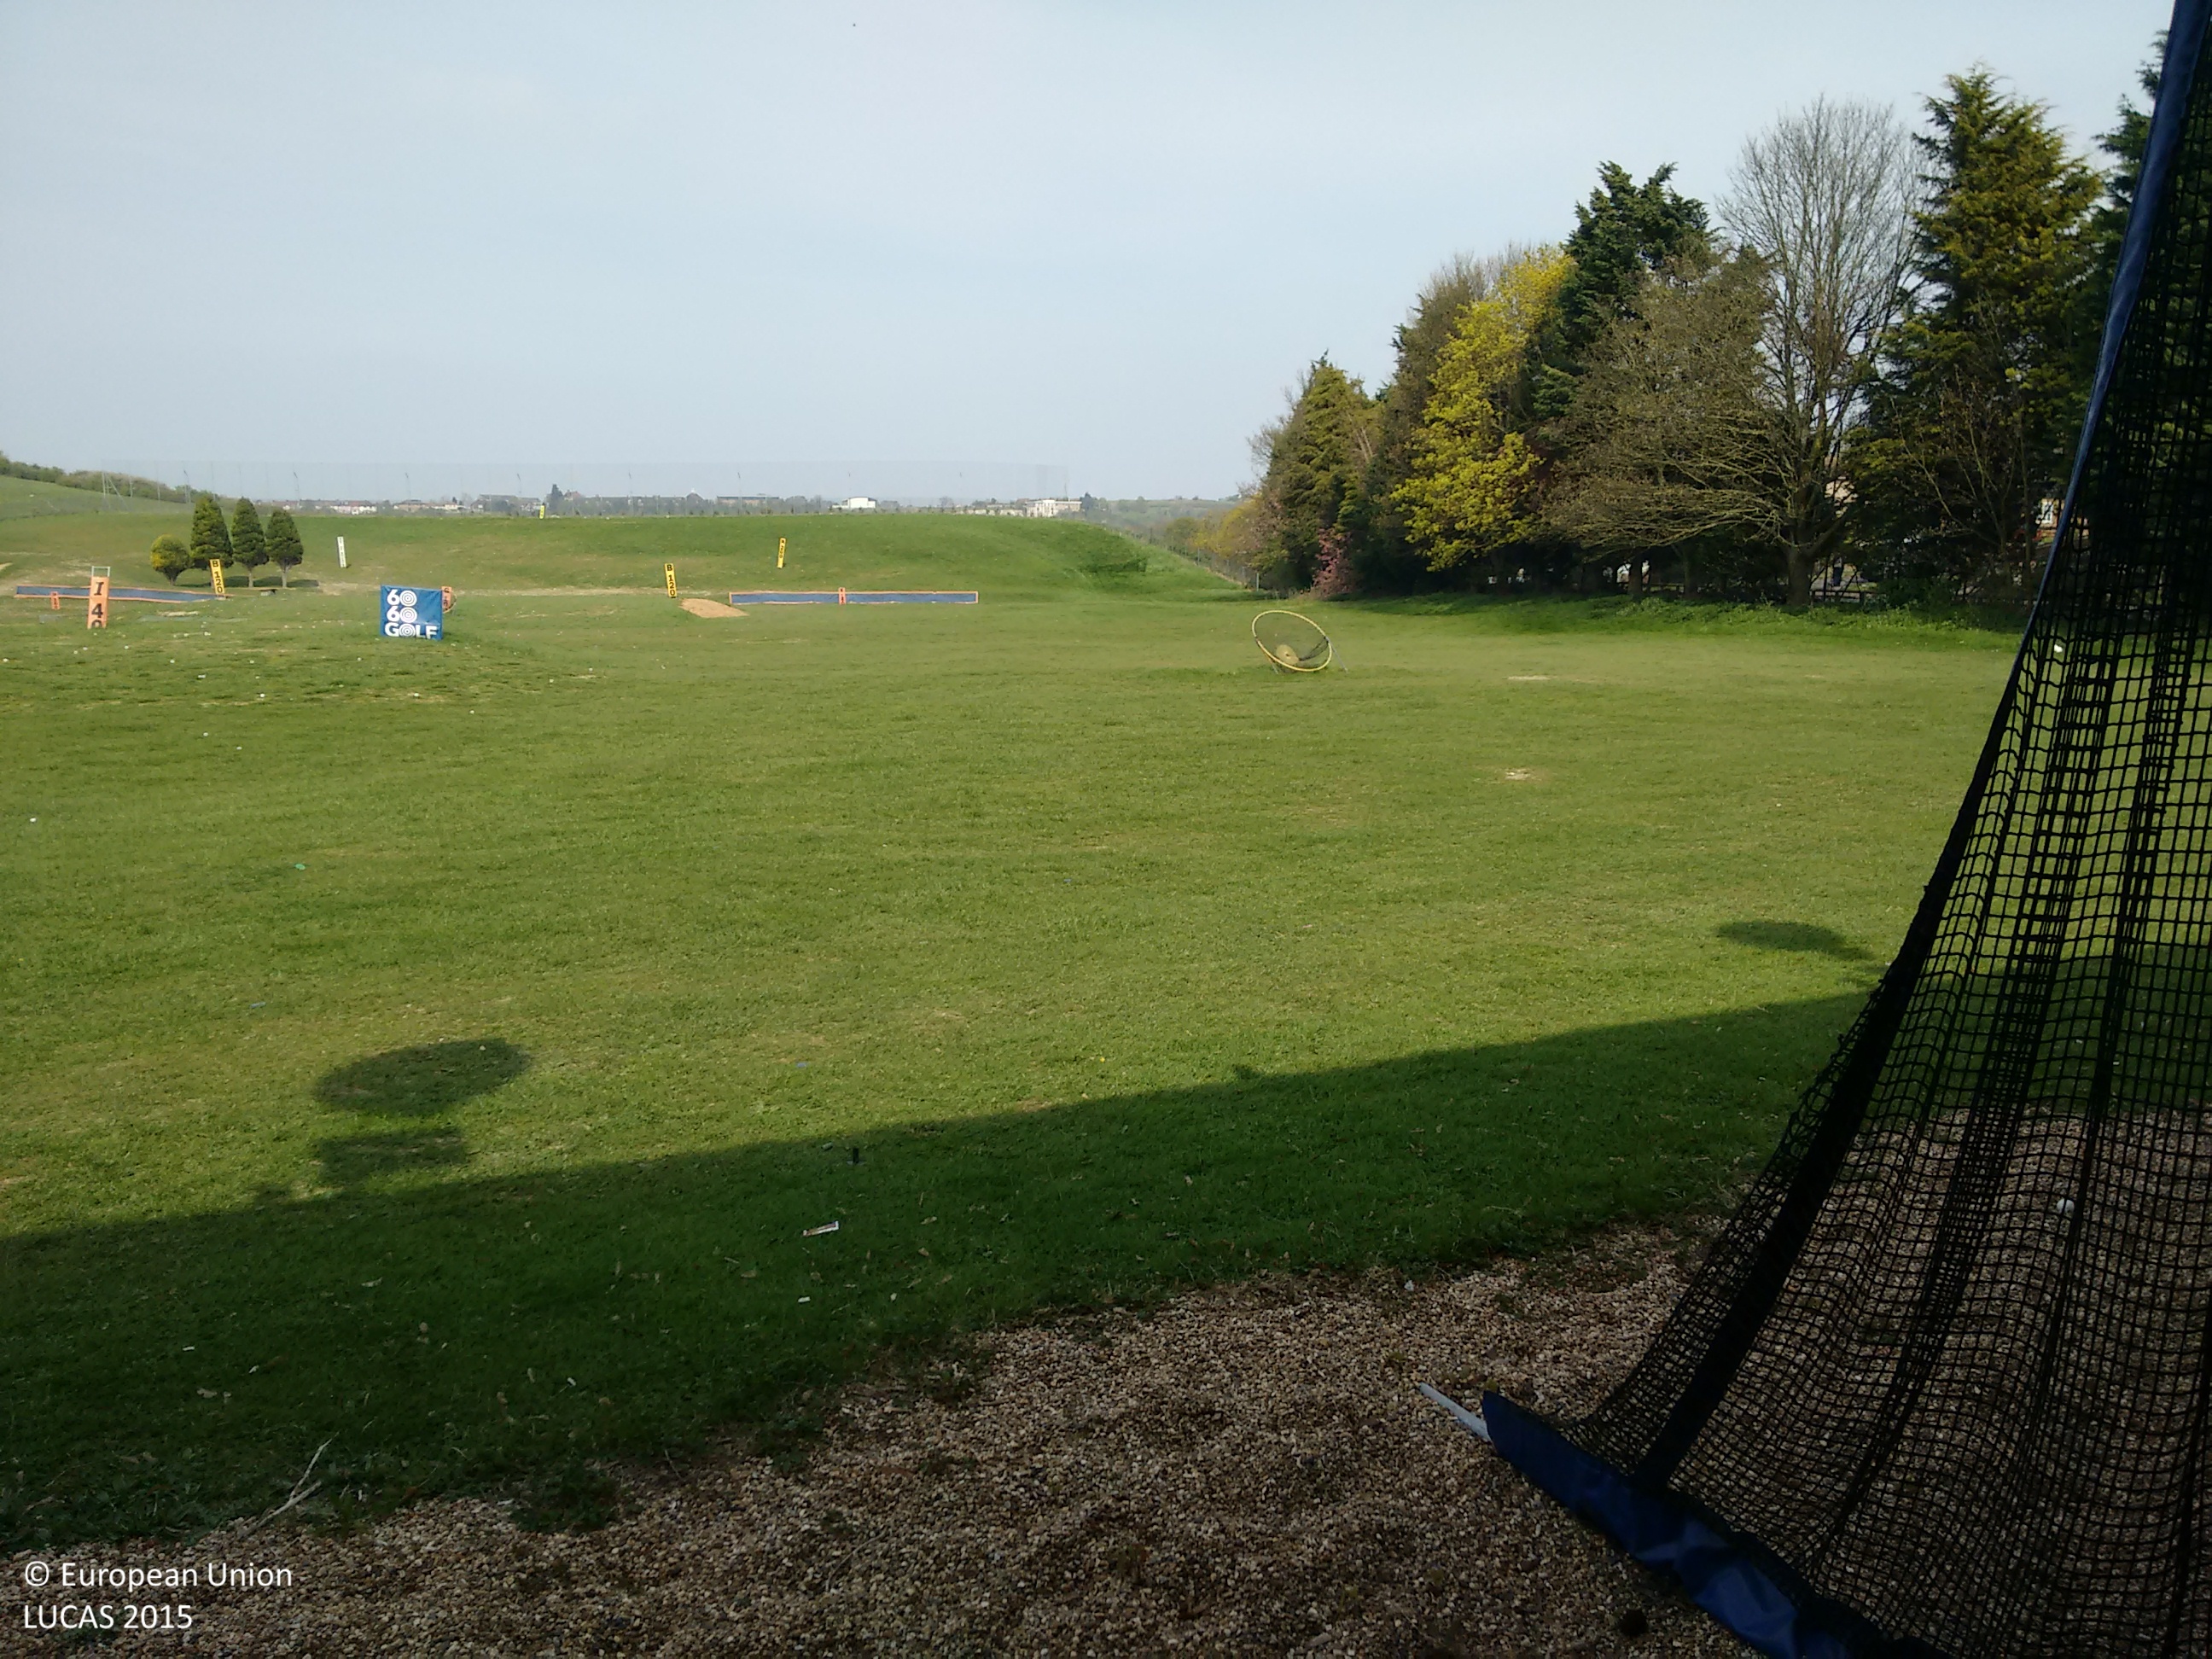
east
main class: Grassland
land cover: Grassland without tree/shrub cover
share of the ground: > 75 %
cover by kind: unconsolidated bare surface 60 %, herbaceous plants 40 %
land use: Sport
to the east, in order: Grassland without tree/shrub cover; Managed hedges; Artificial constructions in urban areas
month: April
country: GB
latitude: 51.3650
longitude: 0.5360
